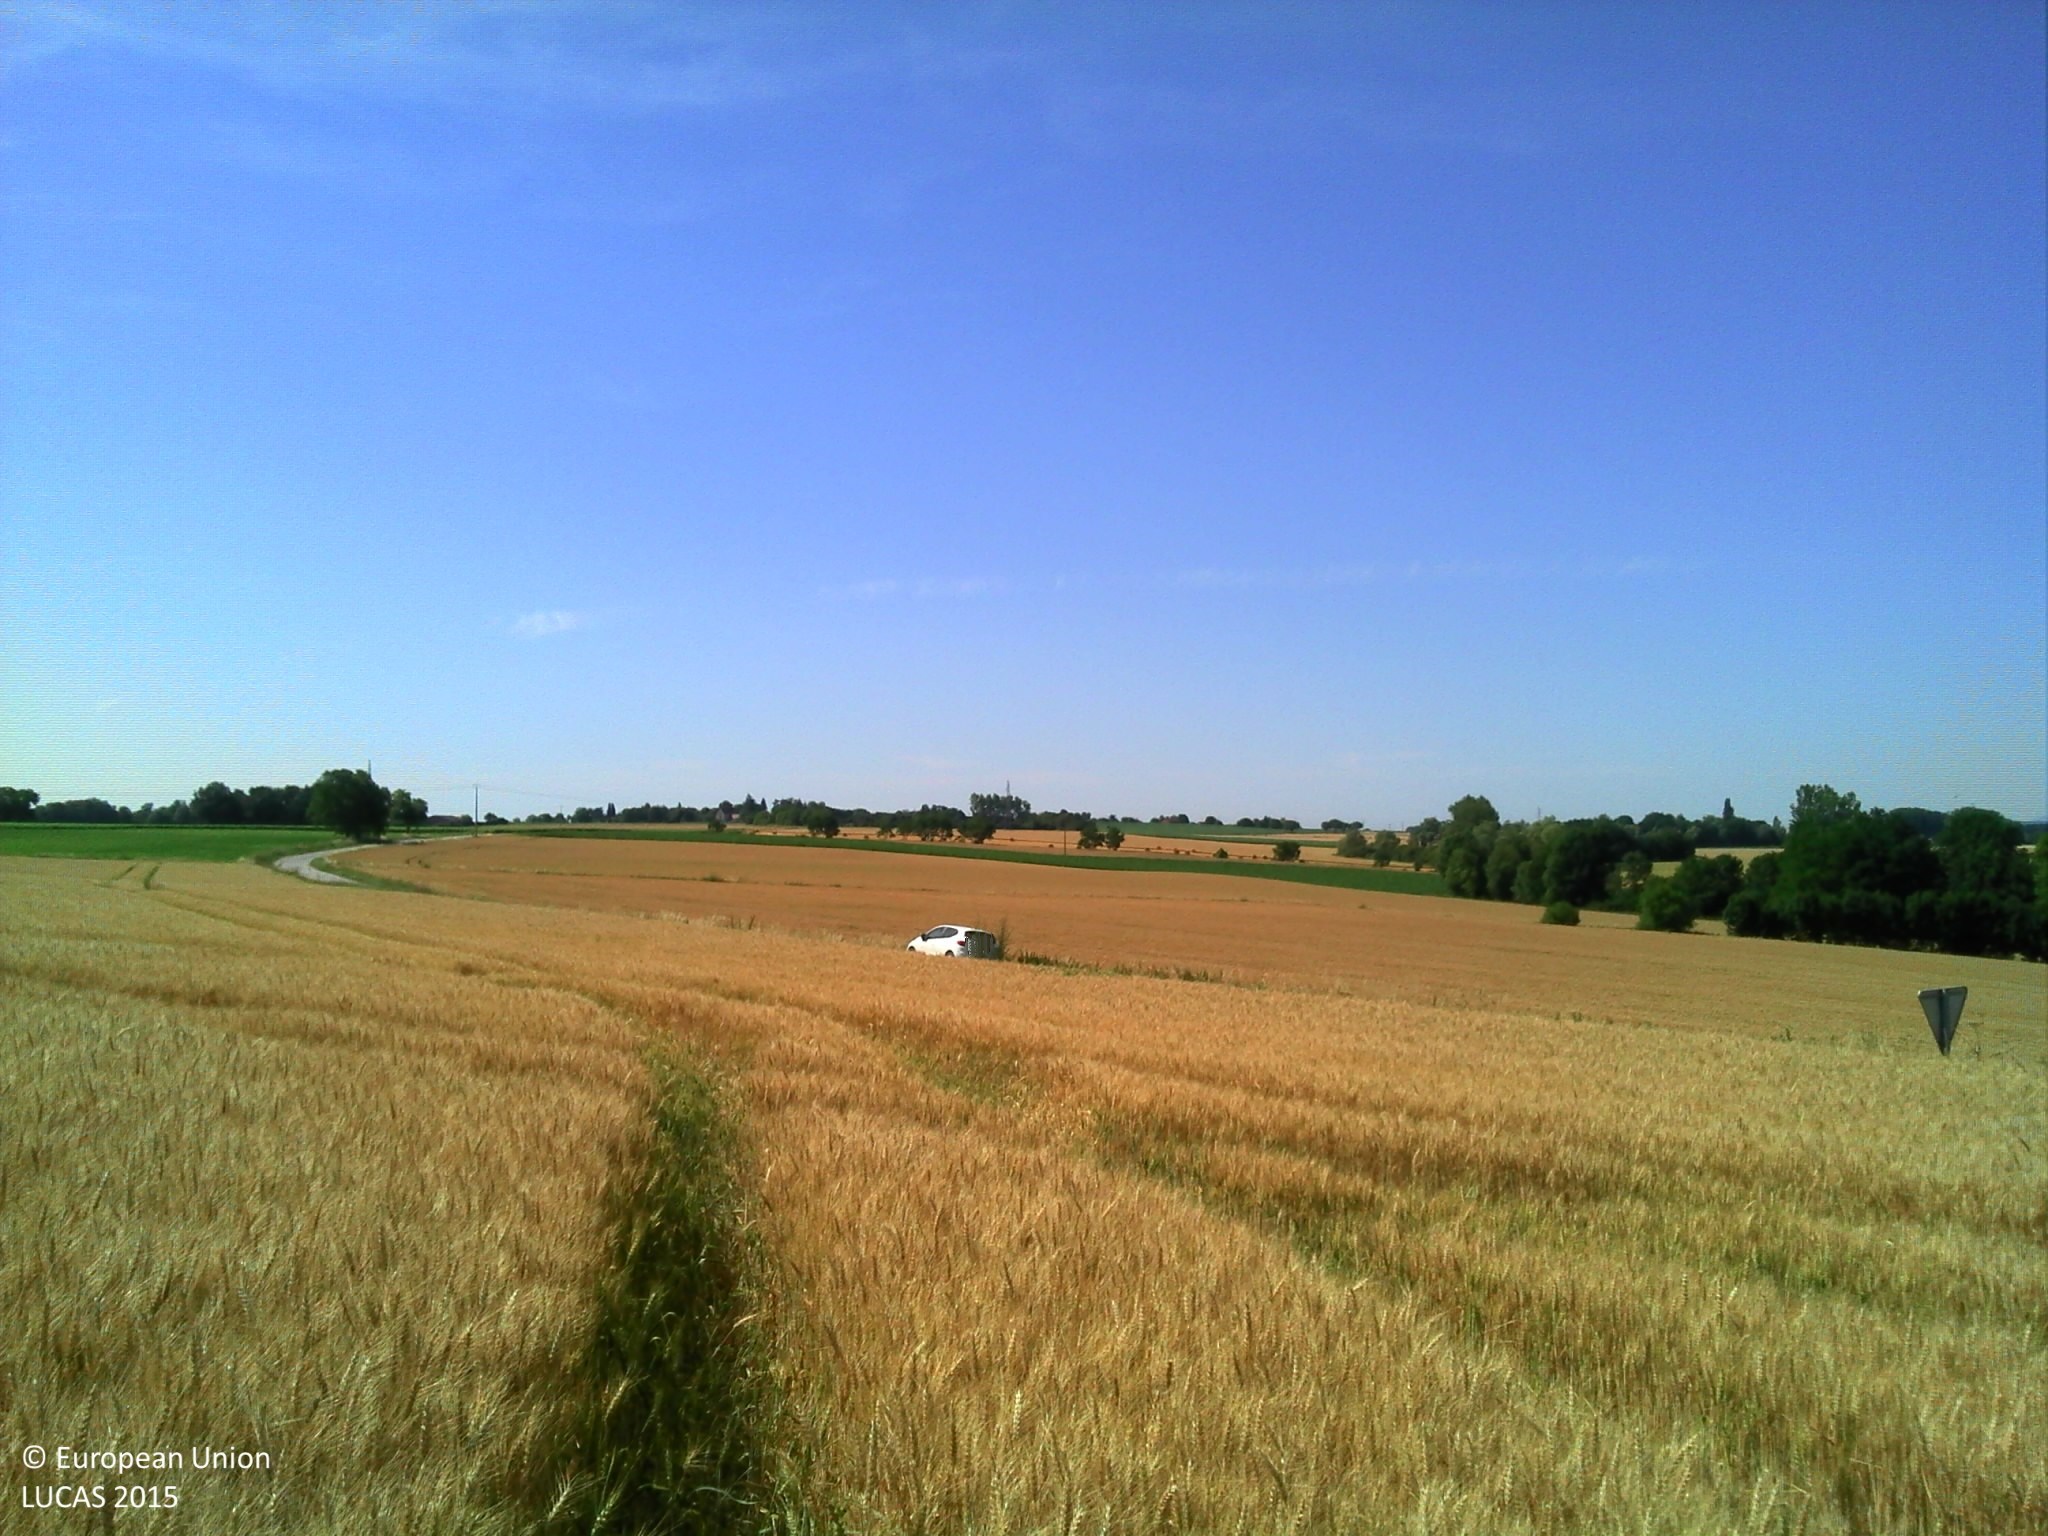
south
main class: Cropland
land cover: Common wheat
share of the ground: > 75 %
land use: Agriculture (excluding fallow land and kitchen gardens)
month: June
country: FR
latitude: 46.2653
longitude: 3.2650
